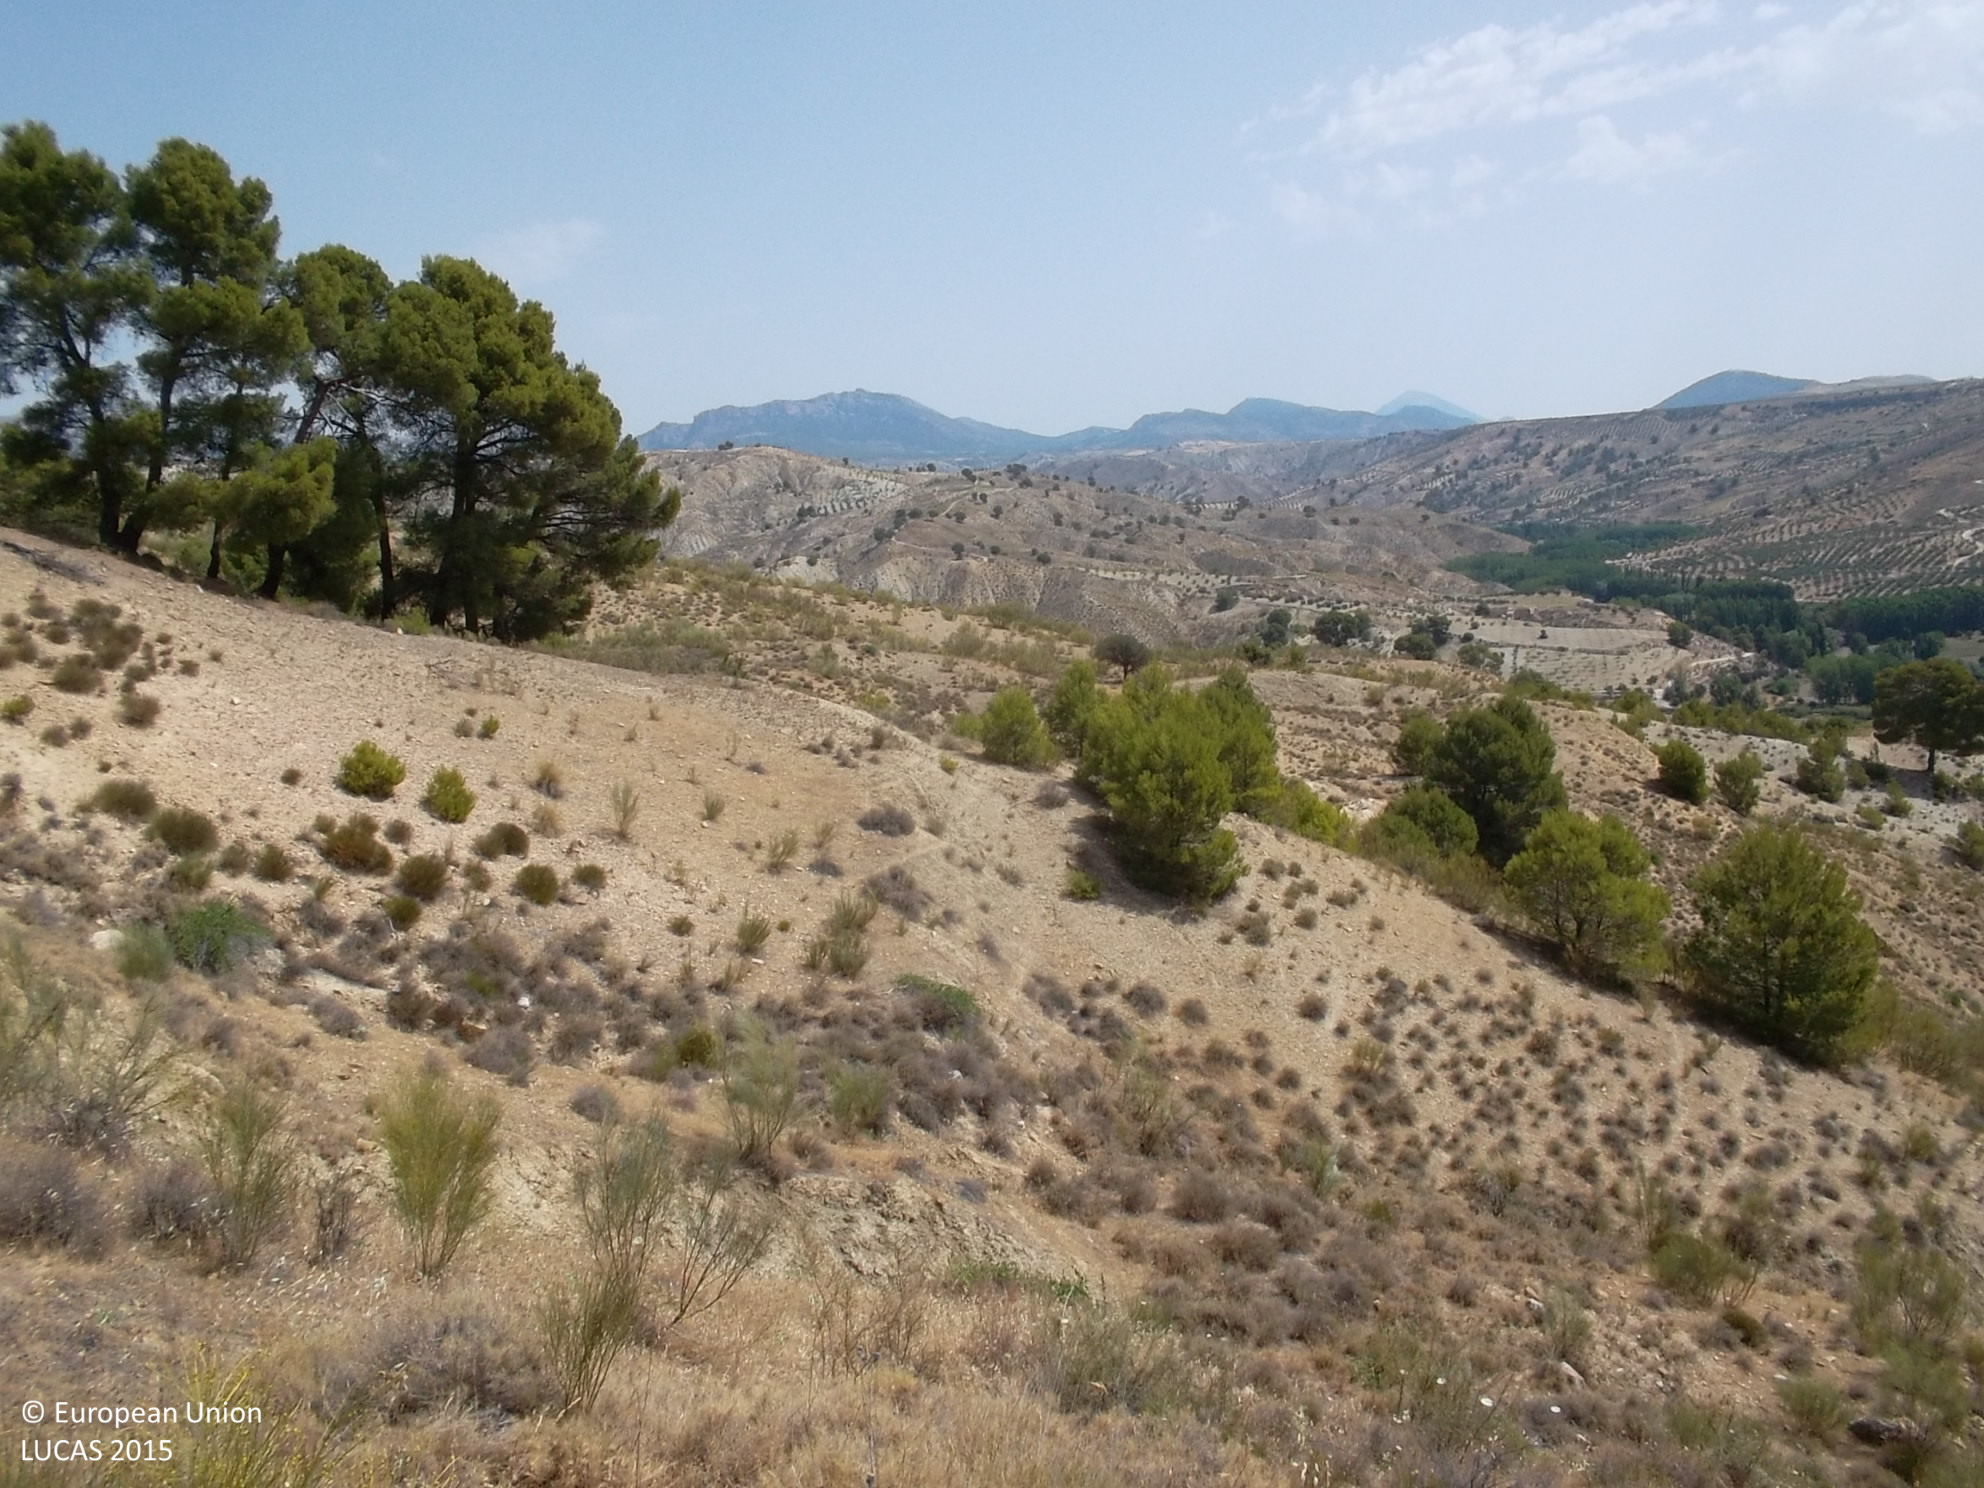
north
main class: Grassland
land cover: Grassland with sparse tree/shrub cover
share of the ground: > 75 %
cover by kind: herbaceous plants 90 %, coniferous forest trees 5 %, shrubs 5 %
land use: Agriculture (excluding fallow land and kitchen gardens)
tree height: < 5 m
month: July
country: ES
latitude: 37.7400
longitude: -2.8028
